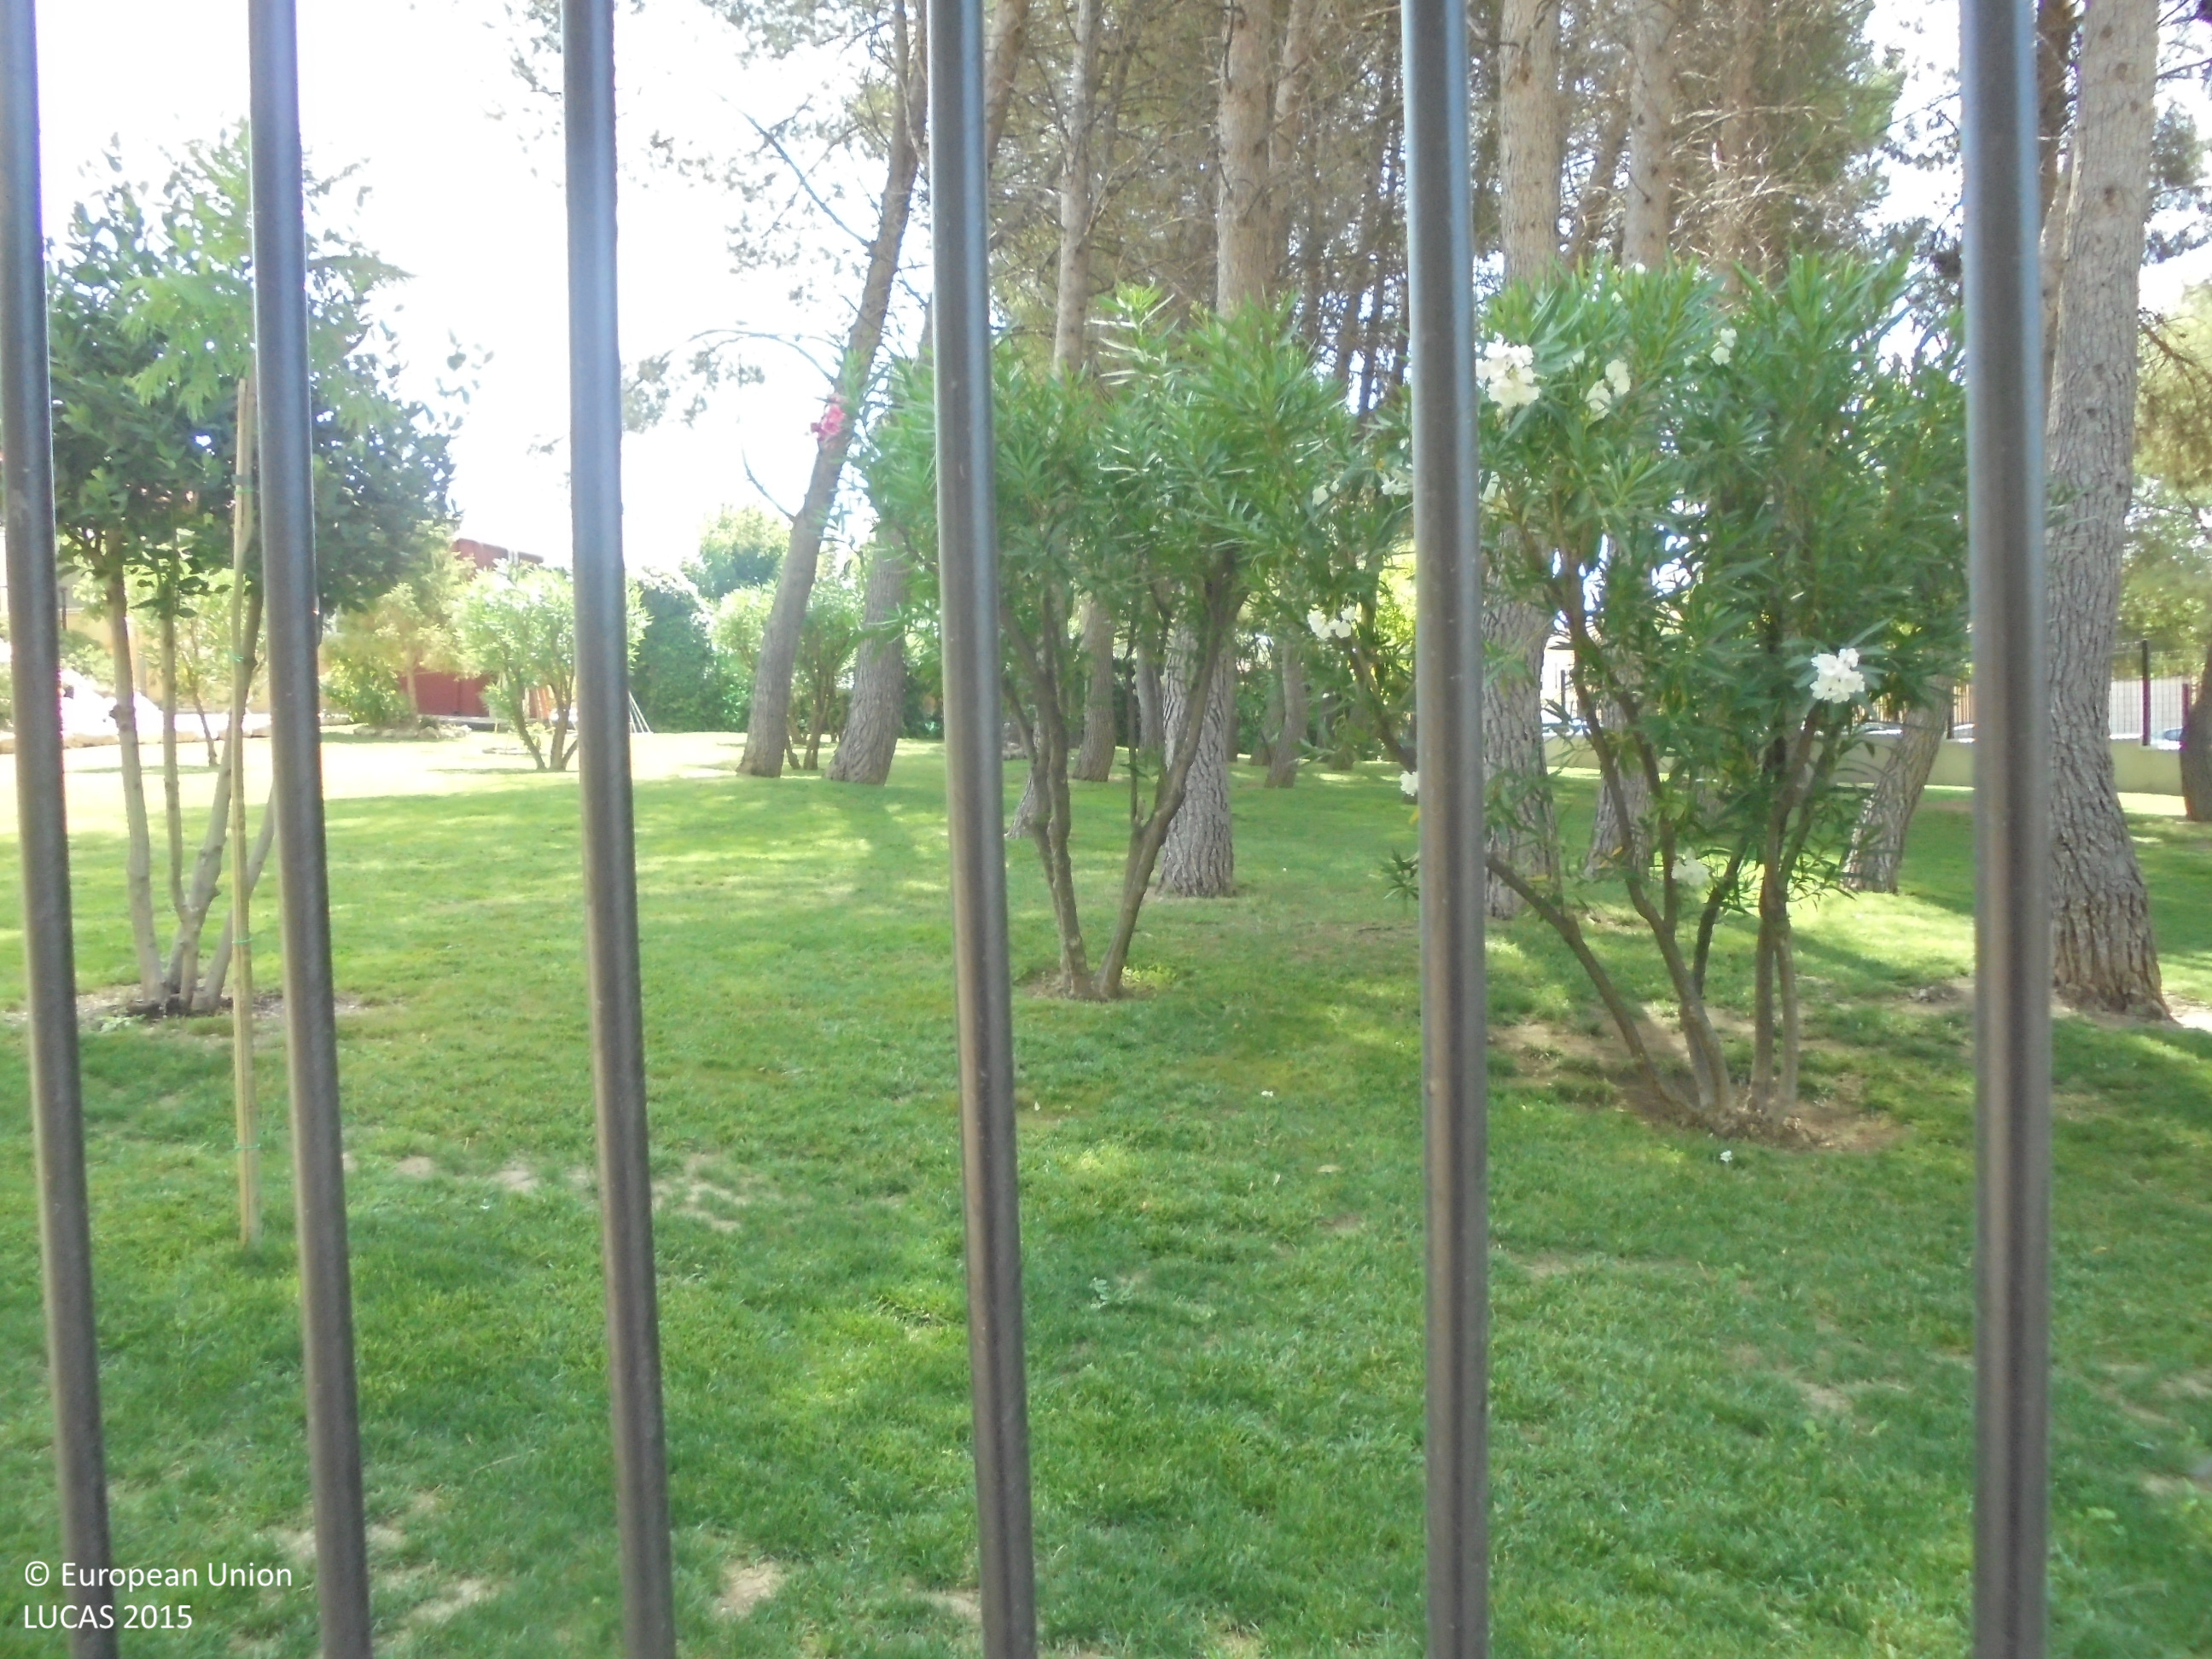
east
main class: Woodland
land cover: Pine dominated coniferous woodland
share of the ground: > 75 %
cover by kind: coniferous forest trees 100 %
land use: Amenities, museums, leisure
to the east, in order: Pine dominated coniferous woodland; Artificial constructions in urban areas
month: July
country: ES
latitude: 38.5969
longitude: -1.6943
